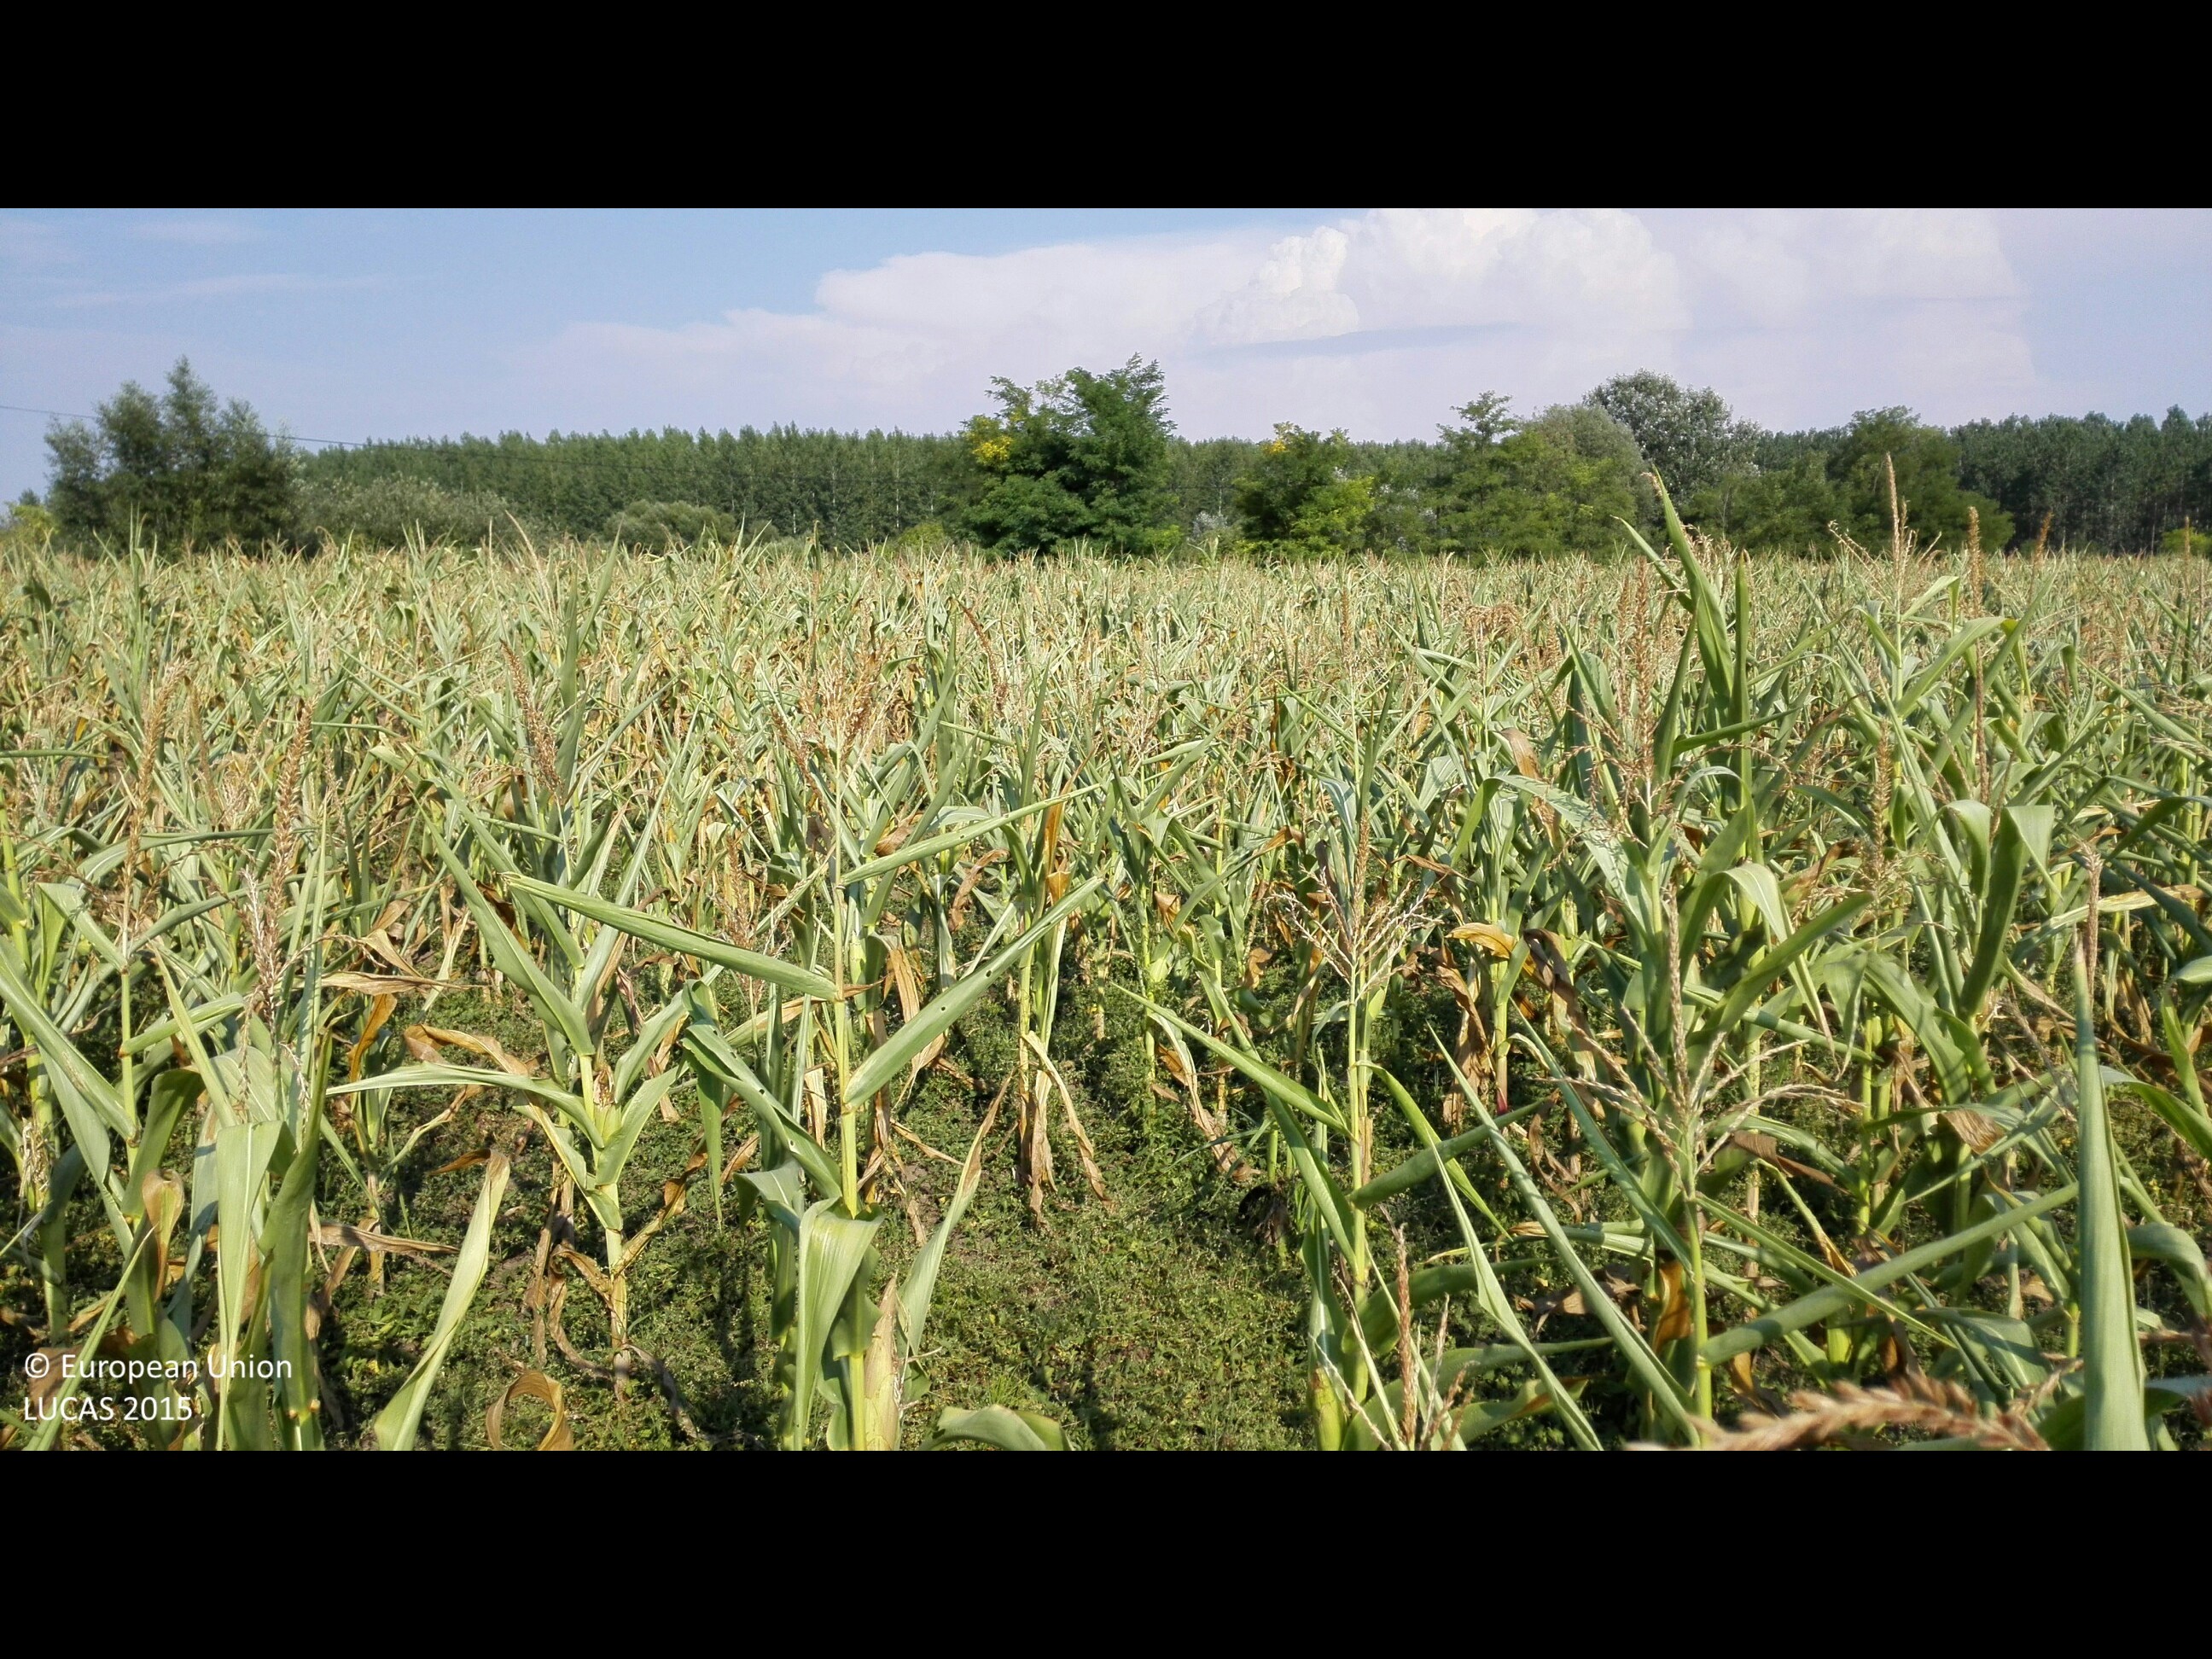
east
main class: Cropland
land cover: Maize
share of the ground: > 75 %
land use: Agriculture (excluding fallow land and kitchen gardens)
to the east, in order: Maize; Abandoned hedges; Electric lines; Tracks; Grass margins; Ditches and canals; Abandoned hedges; Maize; Grassland with sparse tree/shrub cover; Ditches and canals; Abandoned hedges; Common wheat
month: August
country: HU
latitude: 47.6211
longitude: 21.8233
